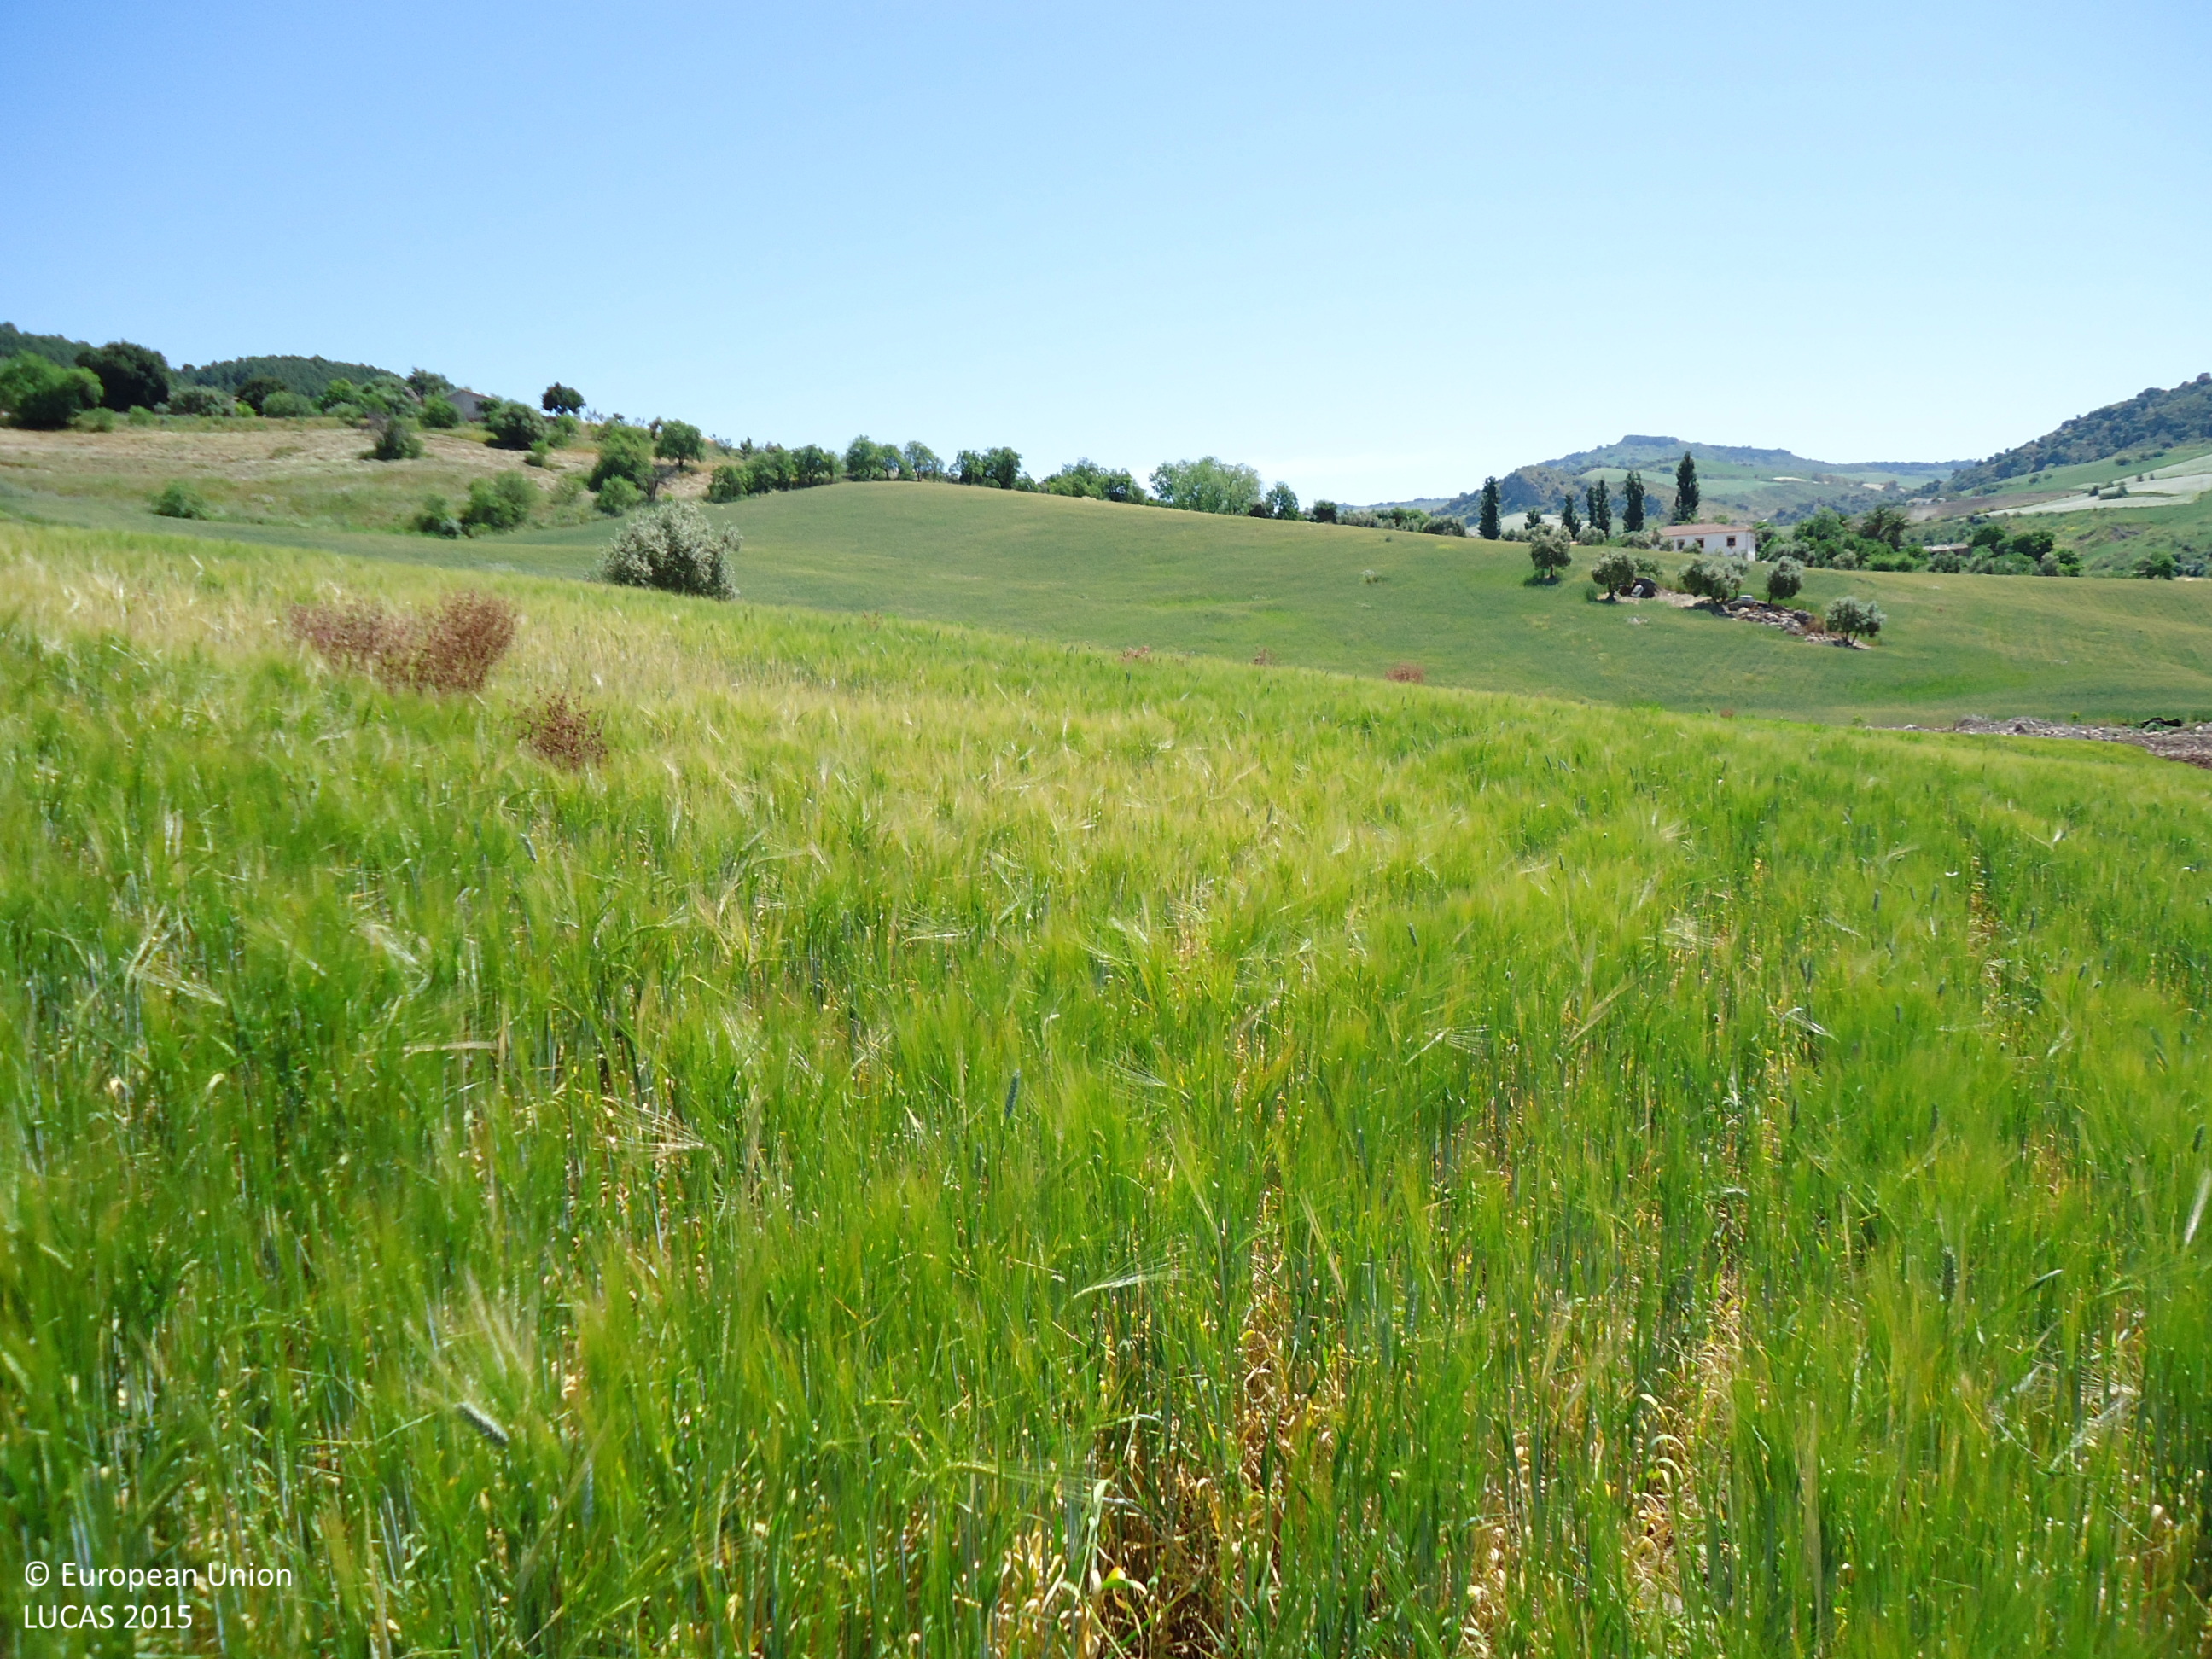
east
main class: Cropland
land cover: Barley
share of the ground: > 75 %
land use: Agriculture (excluding fallow land and kitchen gardens)
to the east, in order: Barley; Rivers and streams; Common wheat; Shruby margins; Common wheat
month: May
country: ES
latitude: 36.8140
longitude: -5.3038
